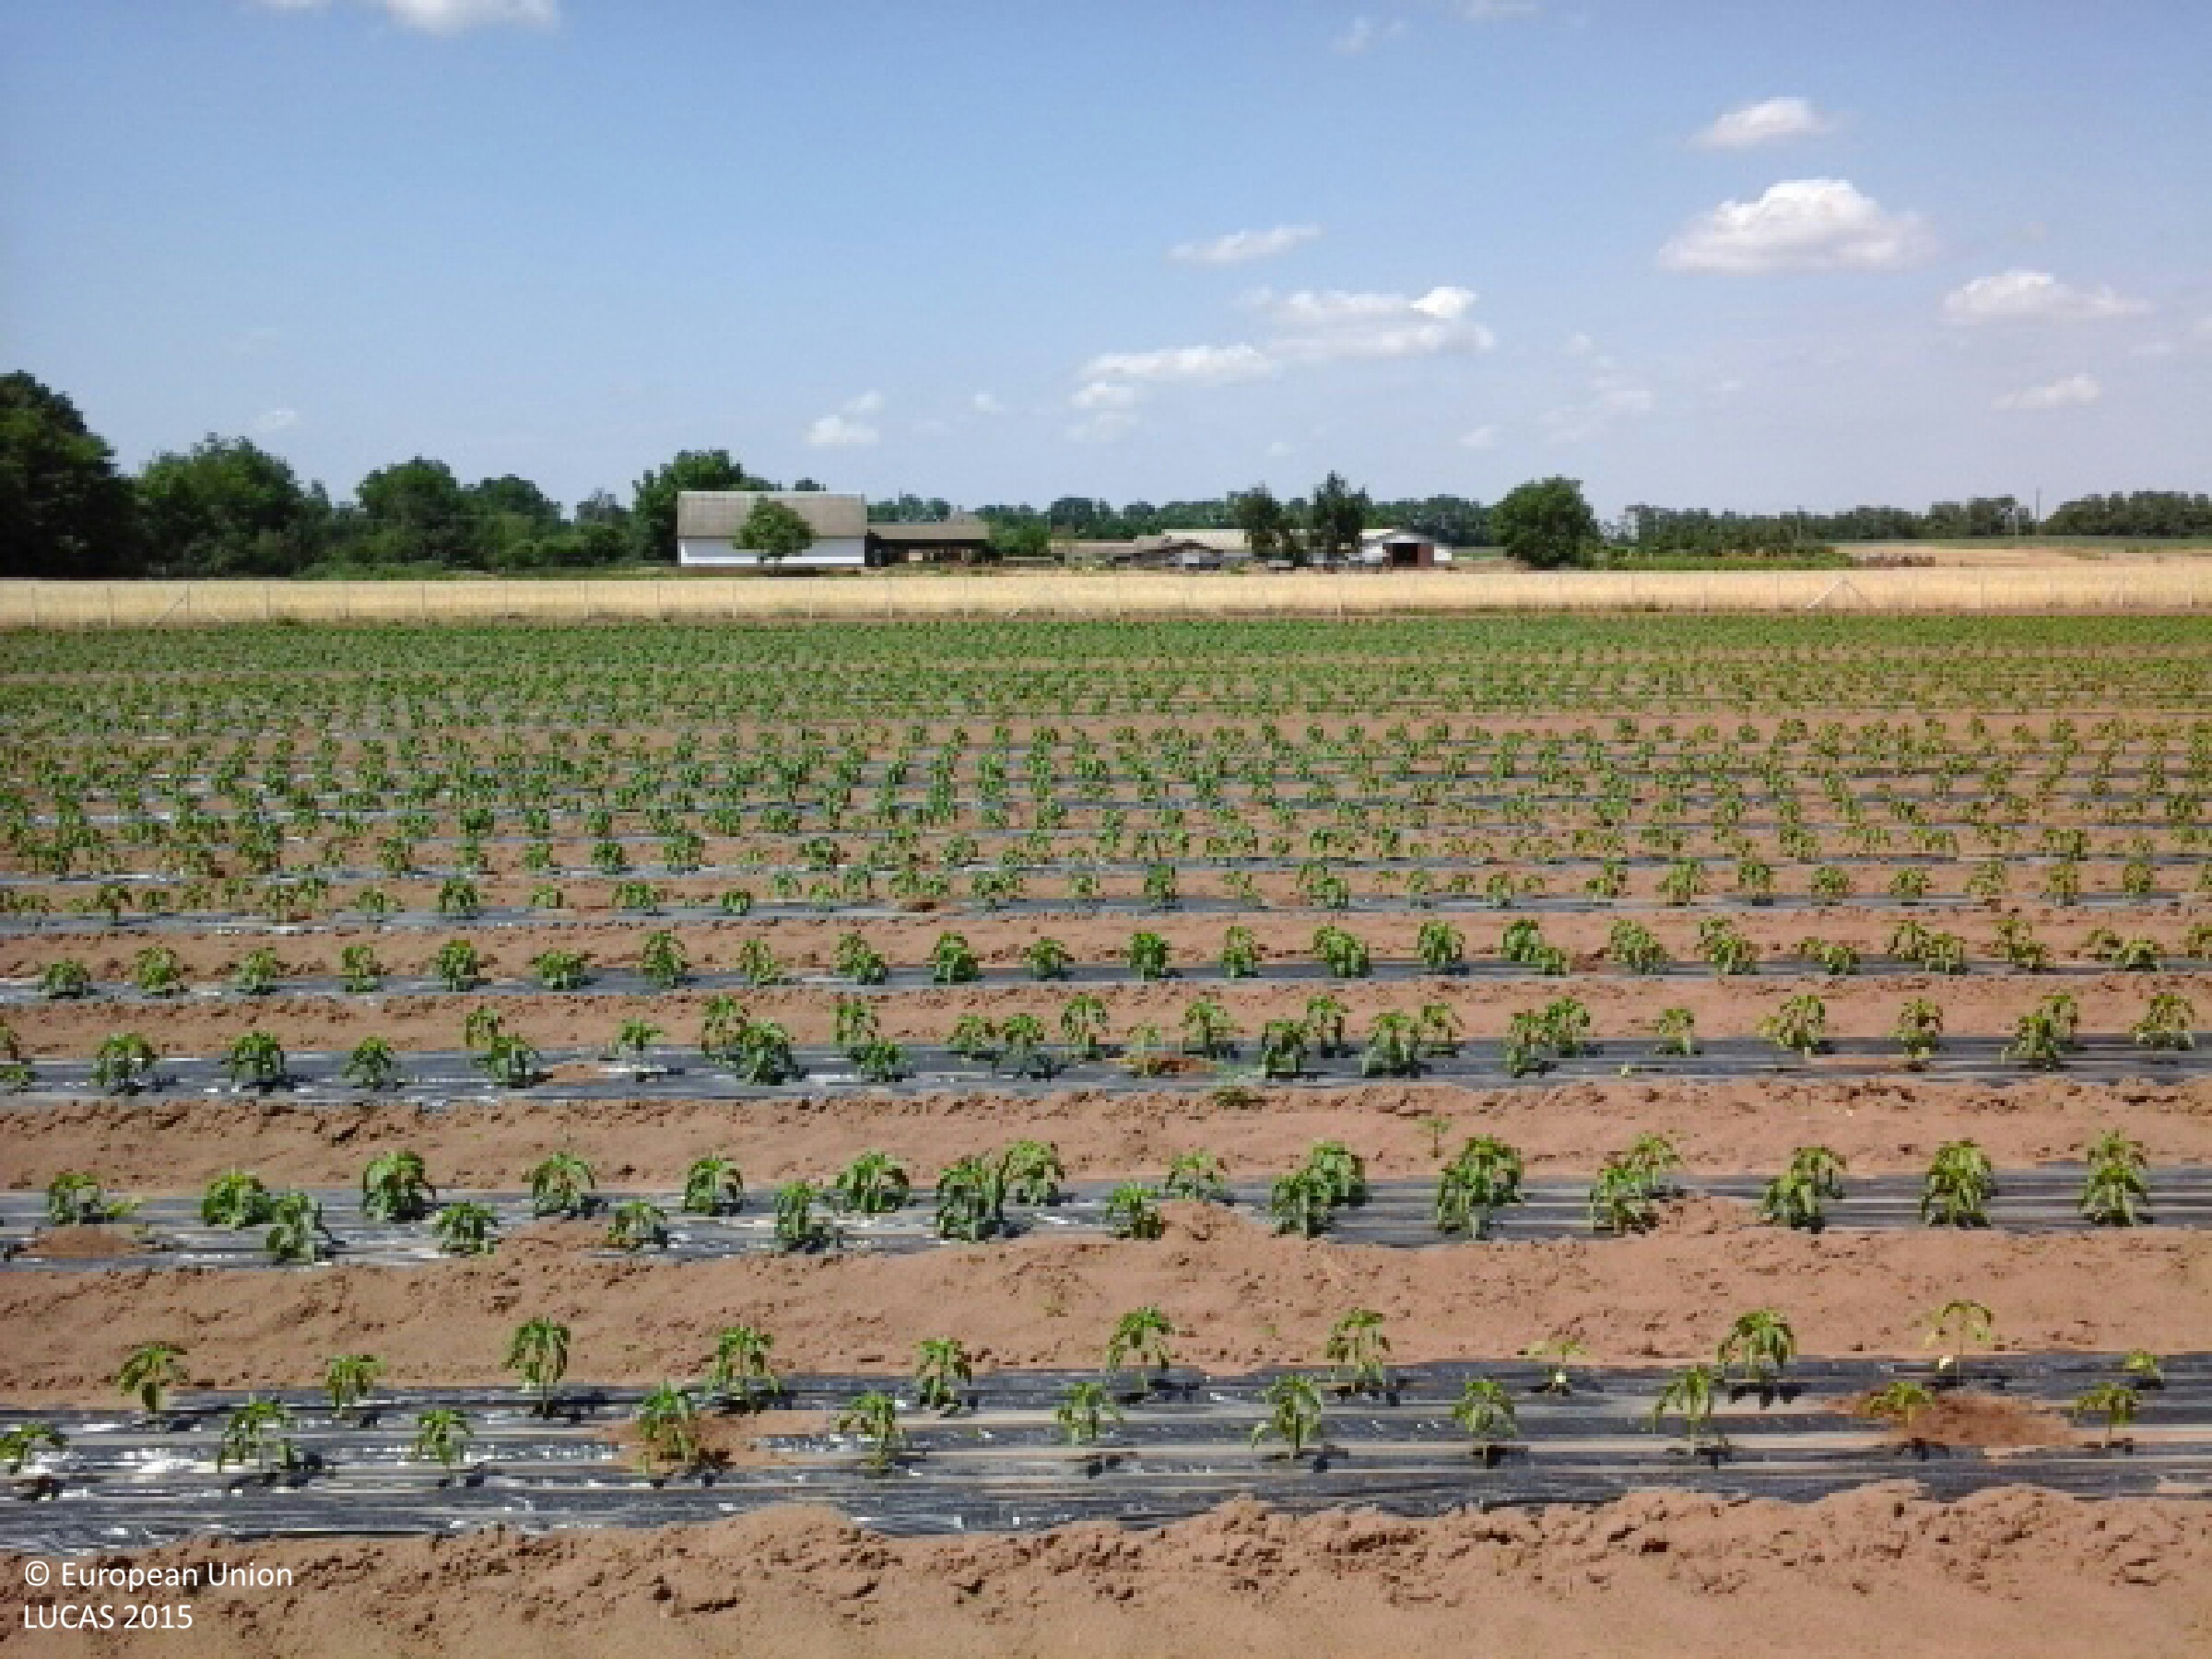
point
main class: Cropland
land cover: Other fresh vegetables
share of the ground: 10 - 25 %
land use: Agriculture (excluding fallow land and kitchen gardens)
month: June
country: HU
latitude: 47.8745
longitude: 21.6656
